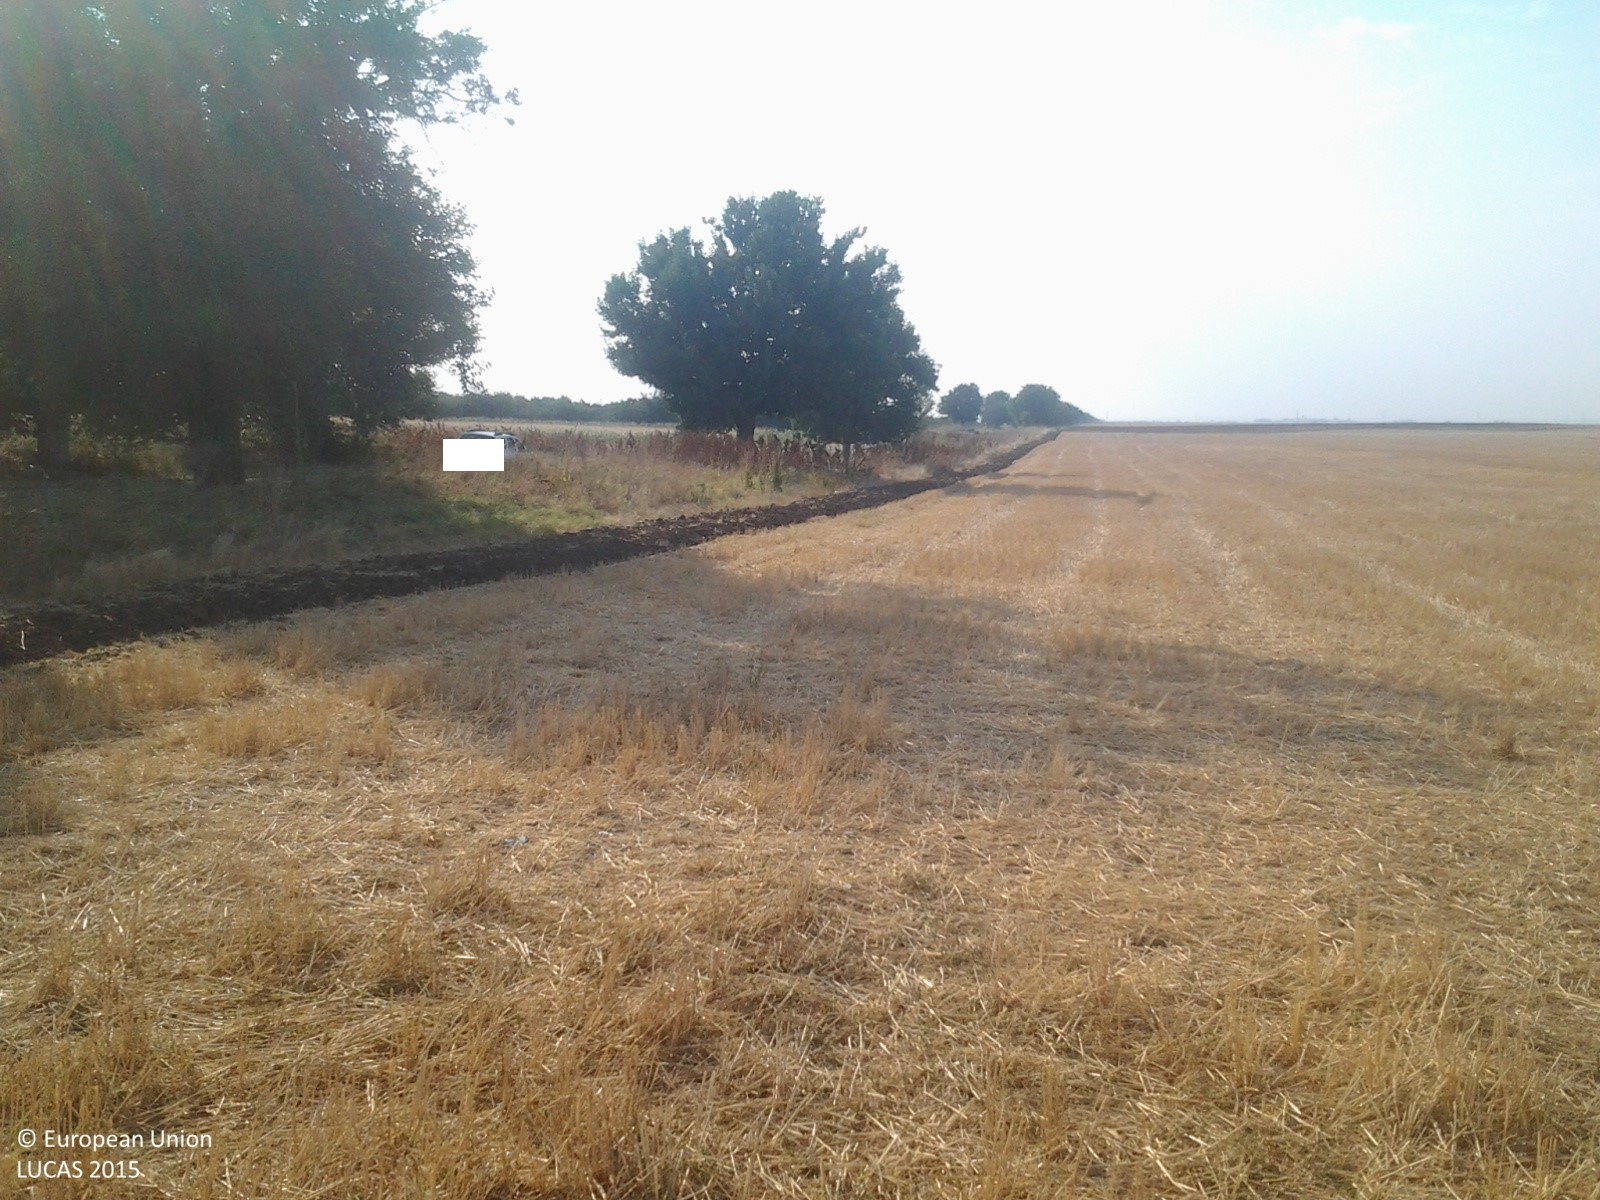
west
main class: Cropland
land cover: Common wheat
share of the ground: > 75 %
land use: Agriculture (excluding fallow land and kitchen gardens)
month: August
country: RO
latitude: 43.9471
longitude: 23.0118
